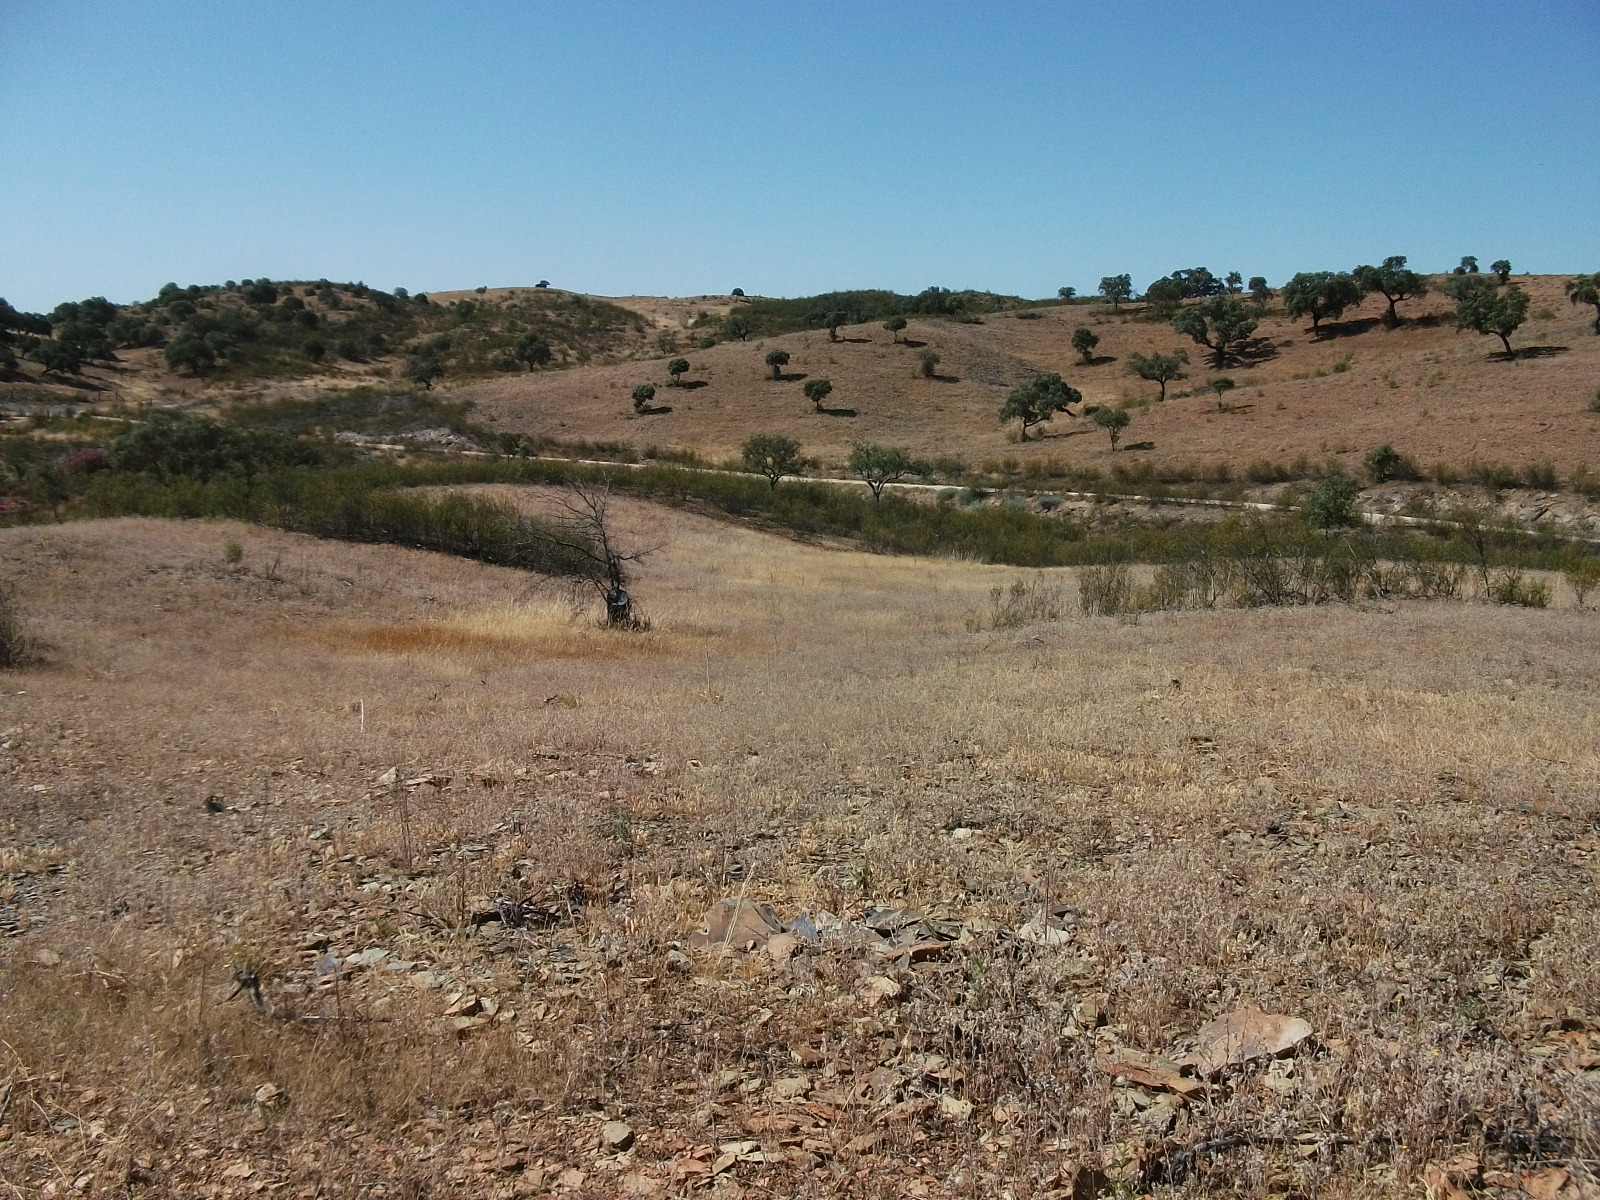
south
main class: Woodland
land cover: Broadleaved woodland
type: broadleaved evergreen forest
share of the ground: 25 - 50 %
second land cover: Grassland without tree/shrub cover
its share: > 75 %
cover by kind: herbaceous plants 70 %, broadleaved forest trees 30 %
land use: Forestry
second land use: Agriculture (excluding fallow land and kitchen gardens)
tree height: > 5 m
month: June
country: ES
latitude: 37.6039
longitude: -7.0263
